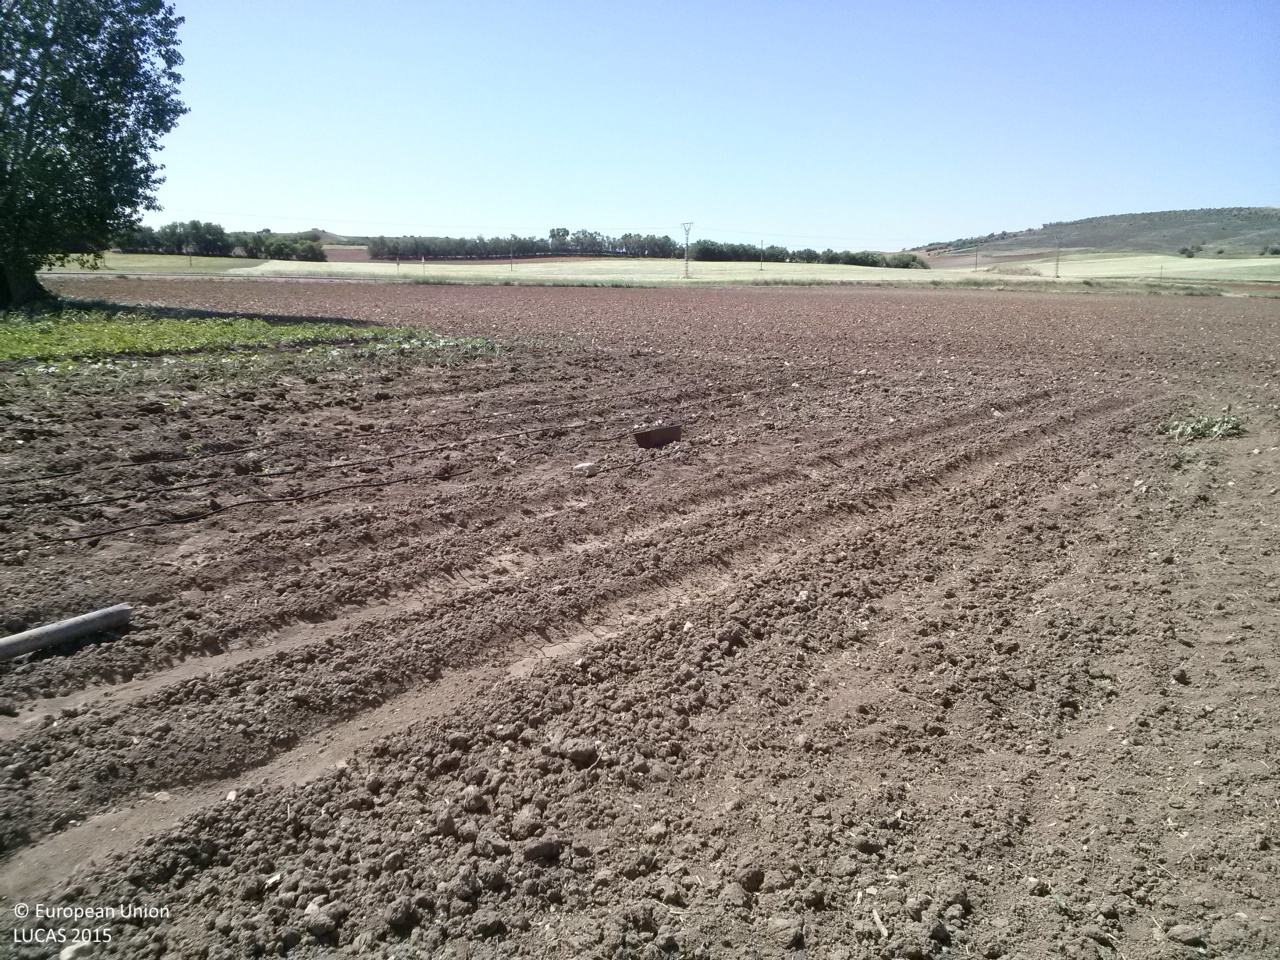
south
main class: Cropland
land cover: Sunflower
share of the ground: < 10 %
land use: Agriculture (excluding fallow land and kitchen gardens)
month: May
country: ES
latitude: 39.9863
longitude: -2.8452
